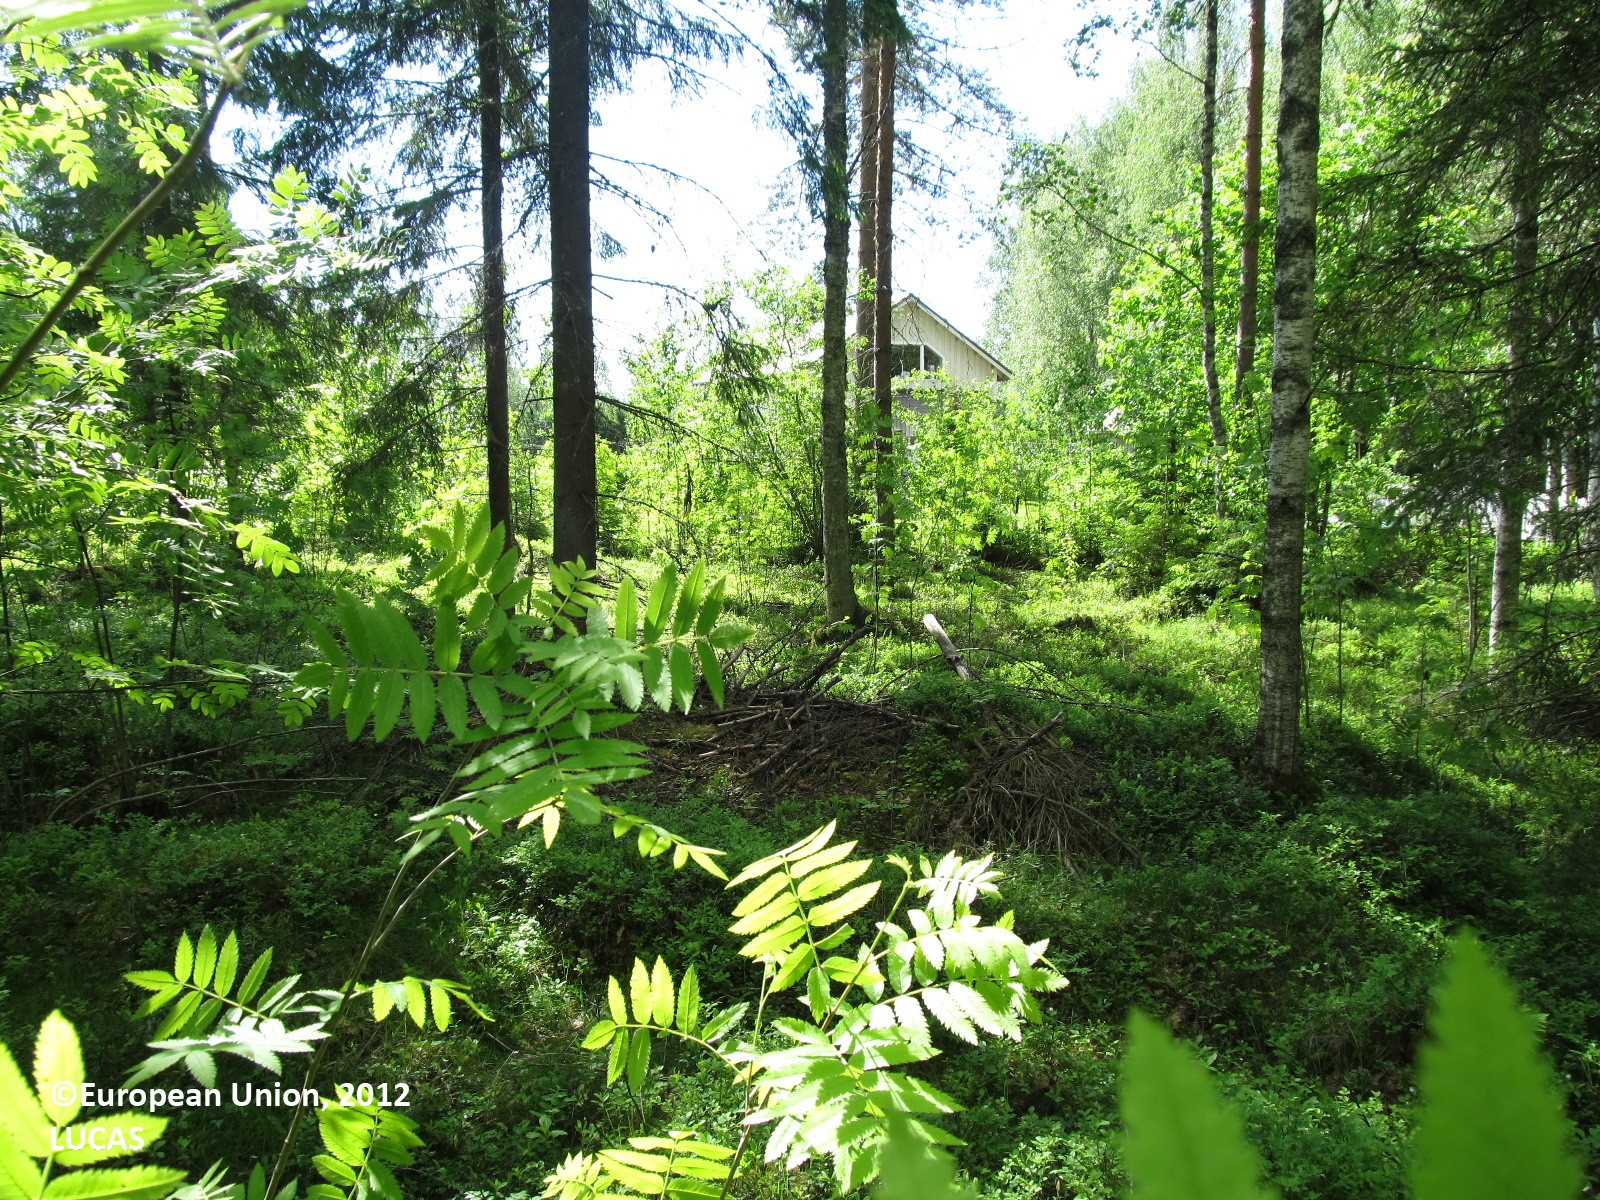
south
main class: Woodland
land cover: Broadleaved woodland
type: boreal forest
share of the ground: 25 - 50 %
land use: Forestry
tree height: > 5 m
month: June
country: FI
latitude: 62.8061
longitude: 27.6038
